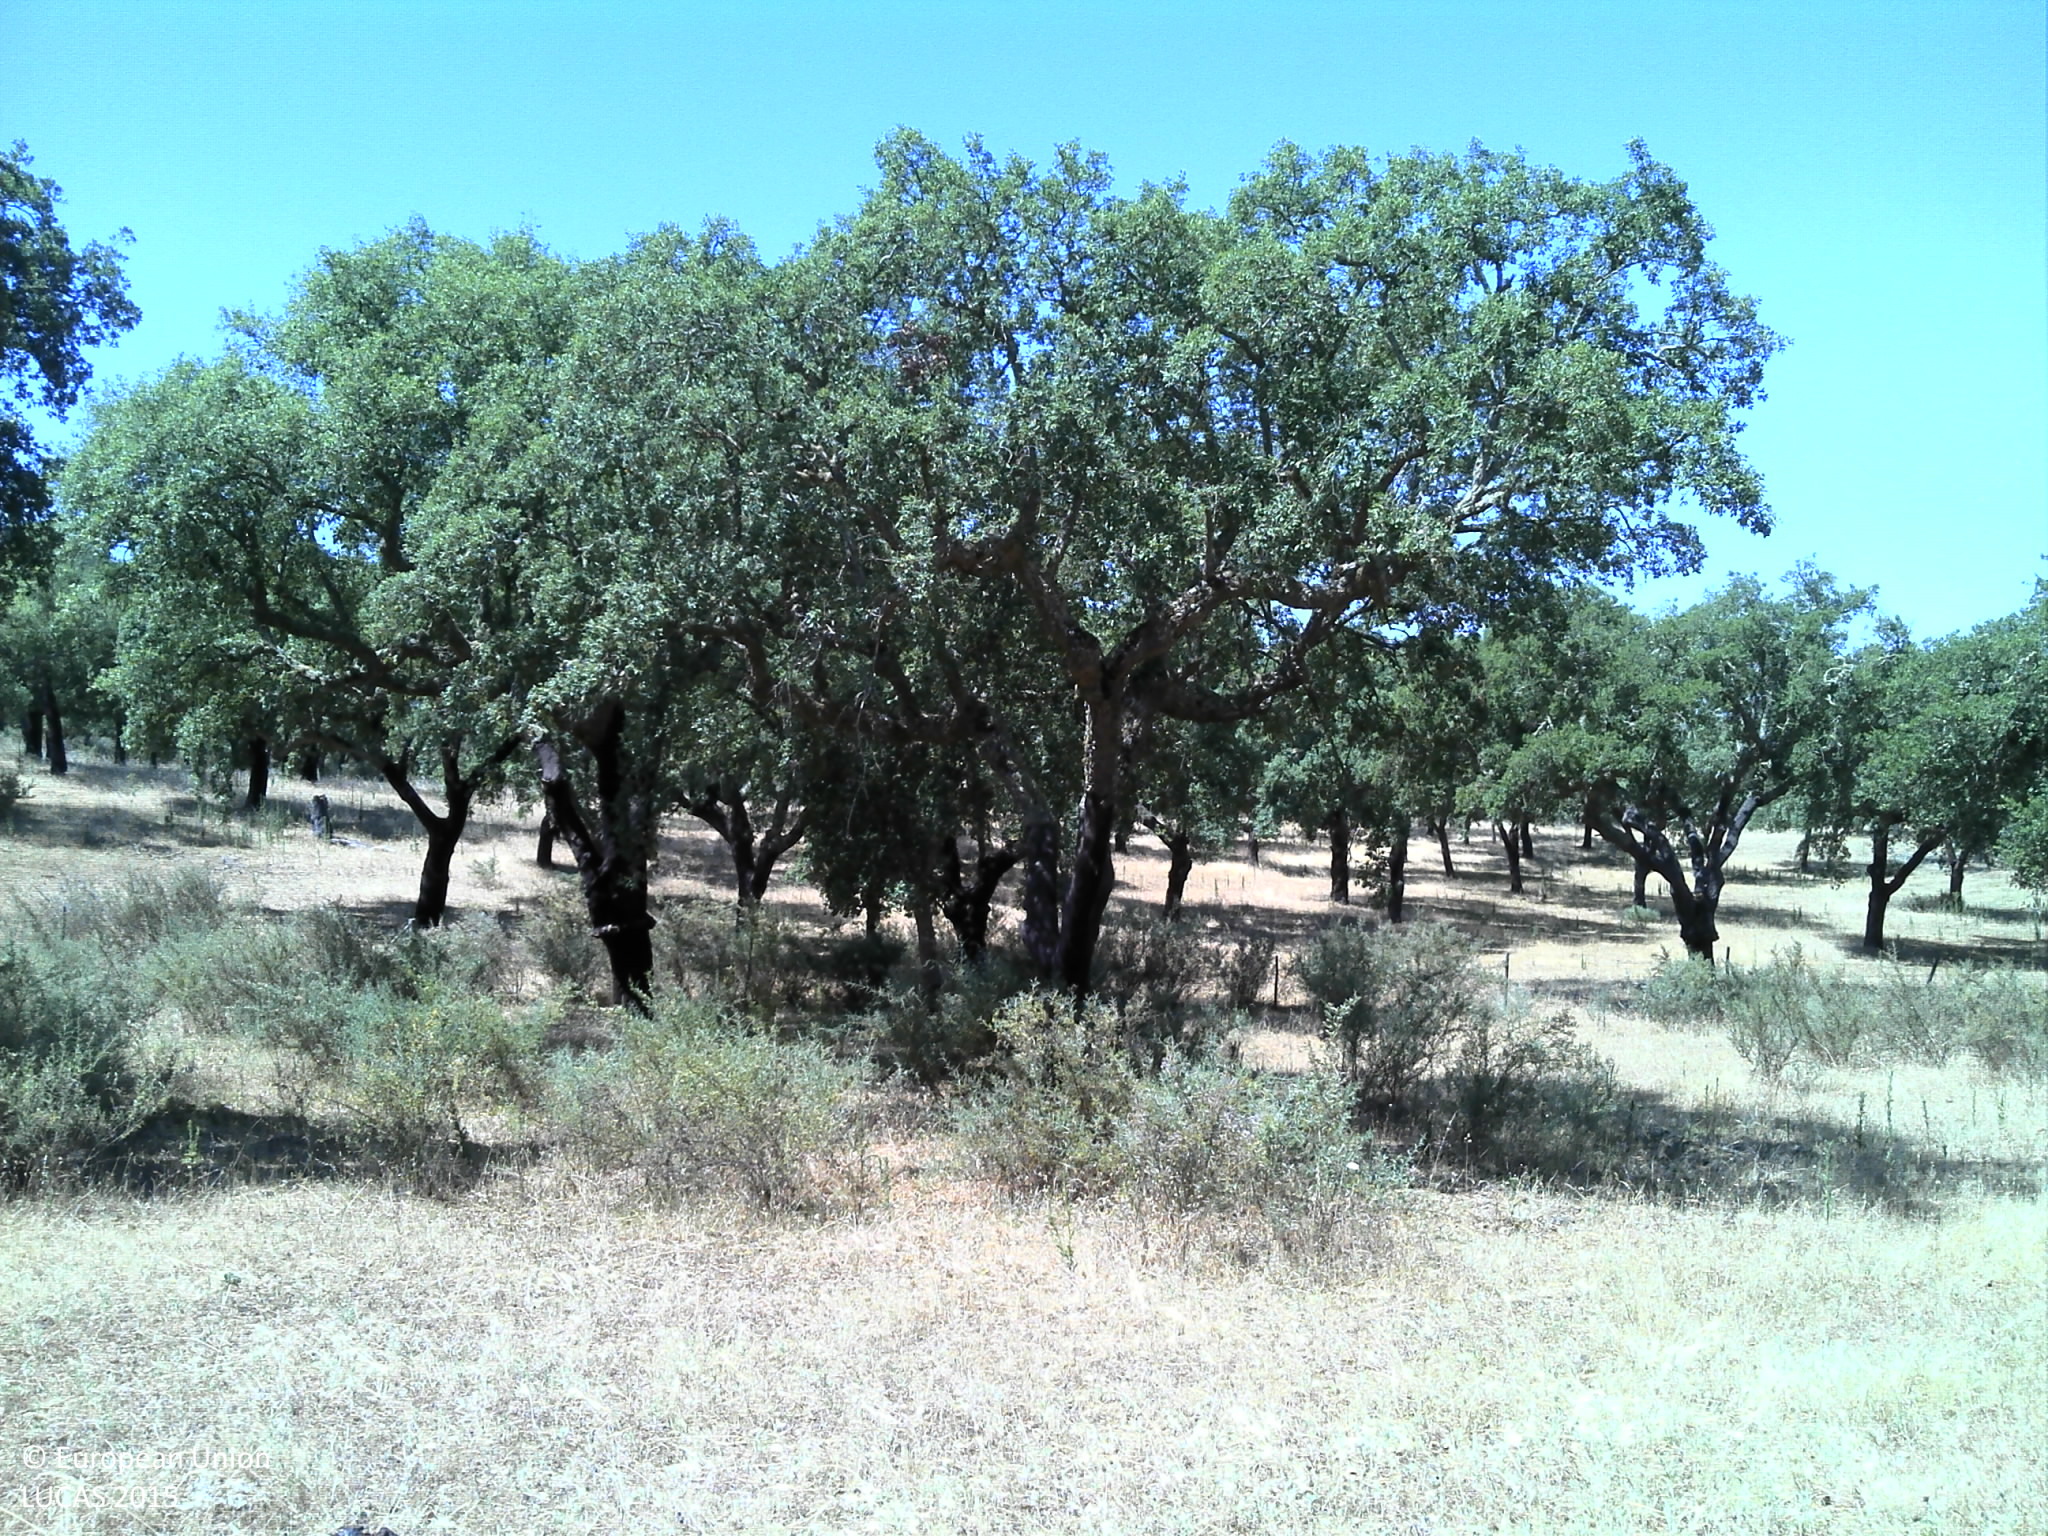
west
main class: Woodland
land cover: Broadleaved woodland
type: broadleaved evergreen forest
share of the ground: 50 - 75 %
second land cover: Grassland without tree/shrub cover
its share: 50 - 75 %
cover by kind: broadleaved forest trees 50 %, herbaceous plants 40 %, unconsolidated bare surface 10 %
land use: Forestry
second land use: Agriculture (excluding fallow land and kitchen gardens)
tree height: > 5 m
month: June
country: PT
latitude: 38.7683
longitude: -7.8229
